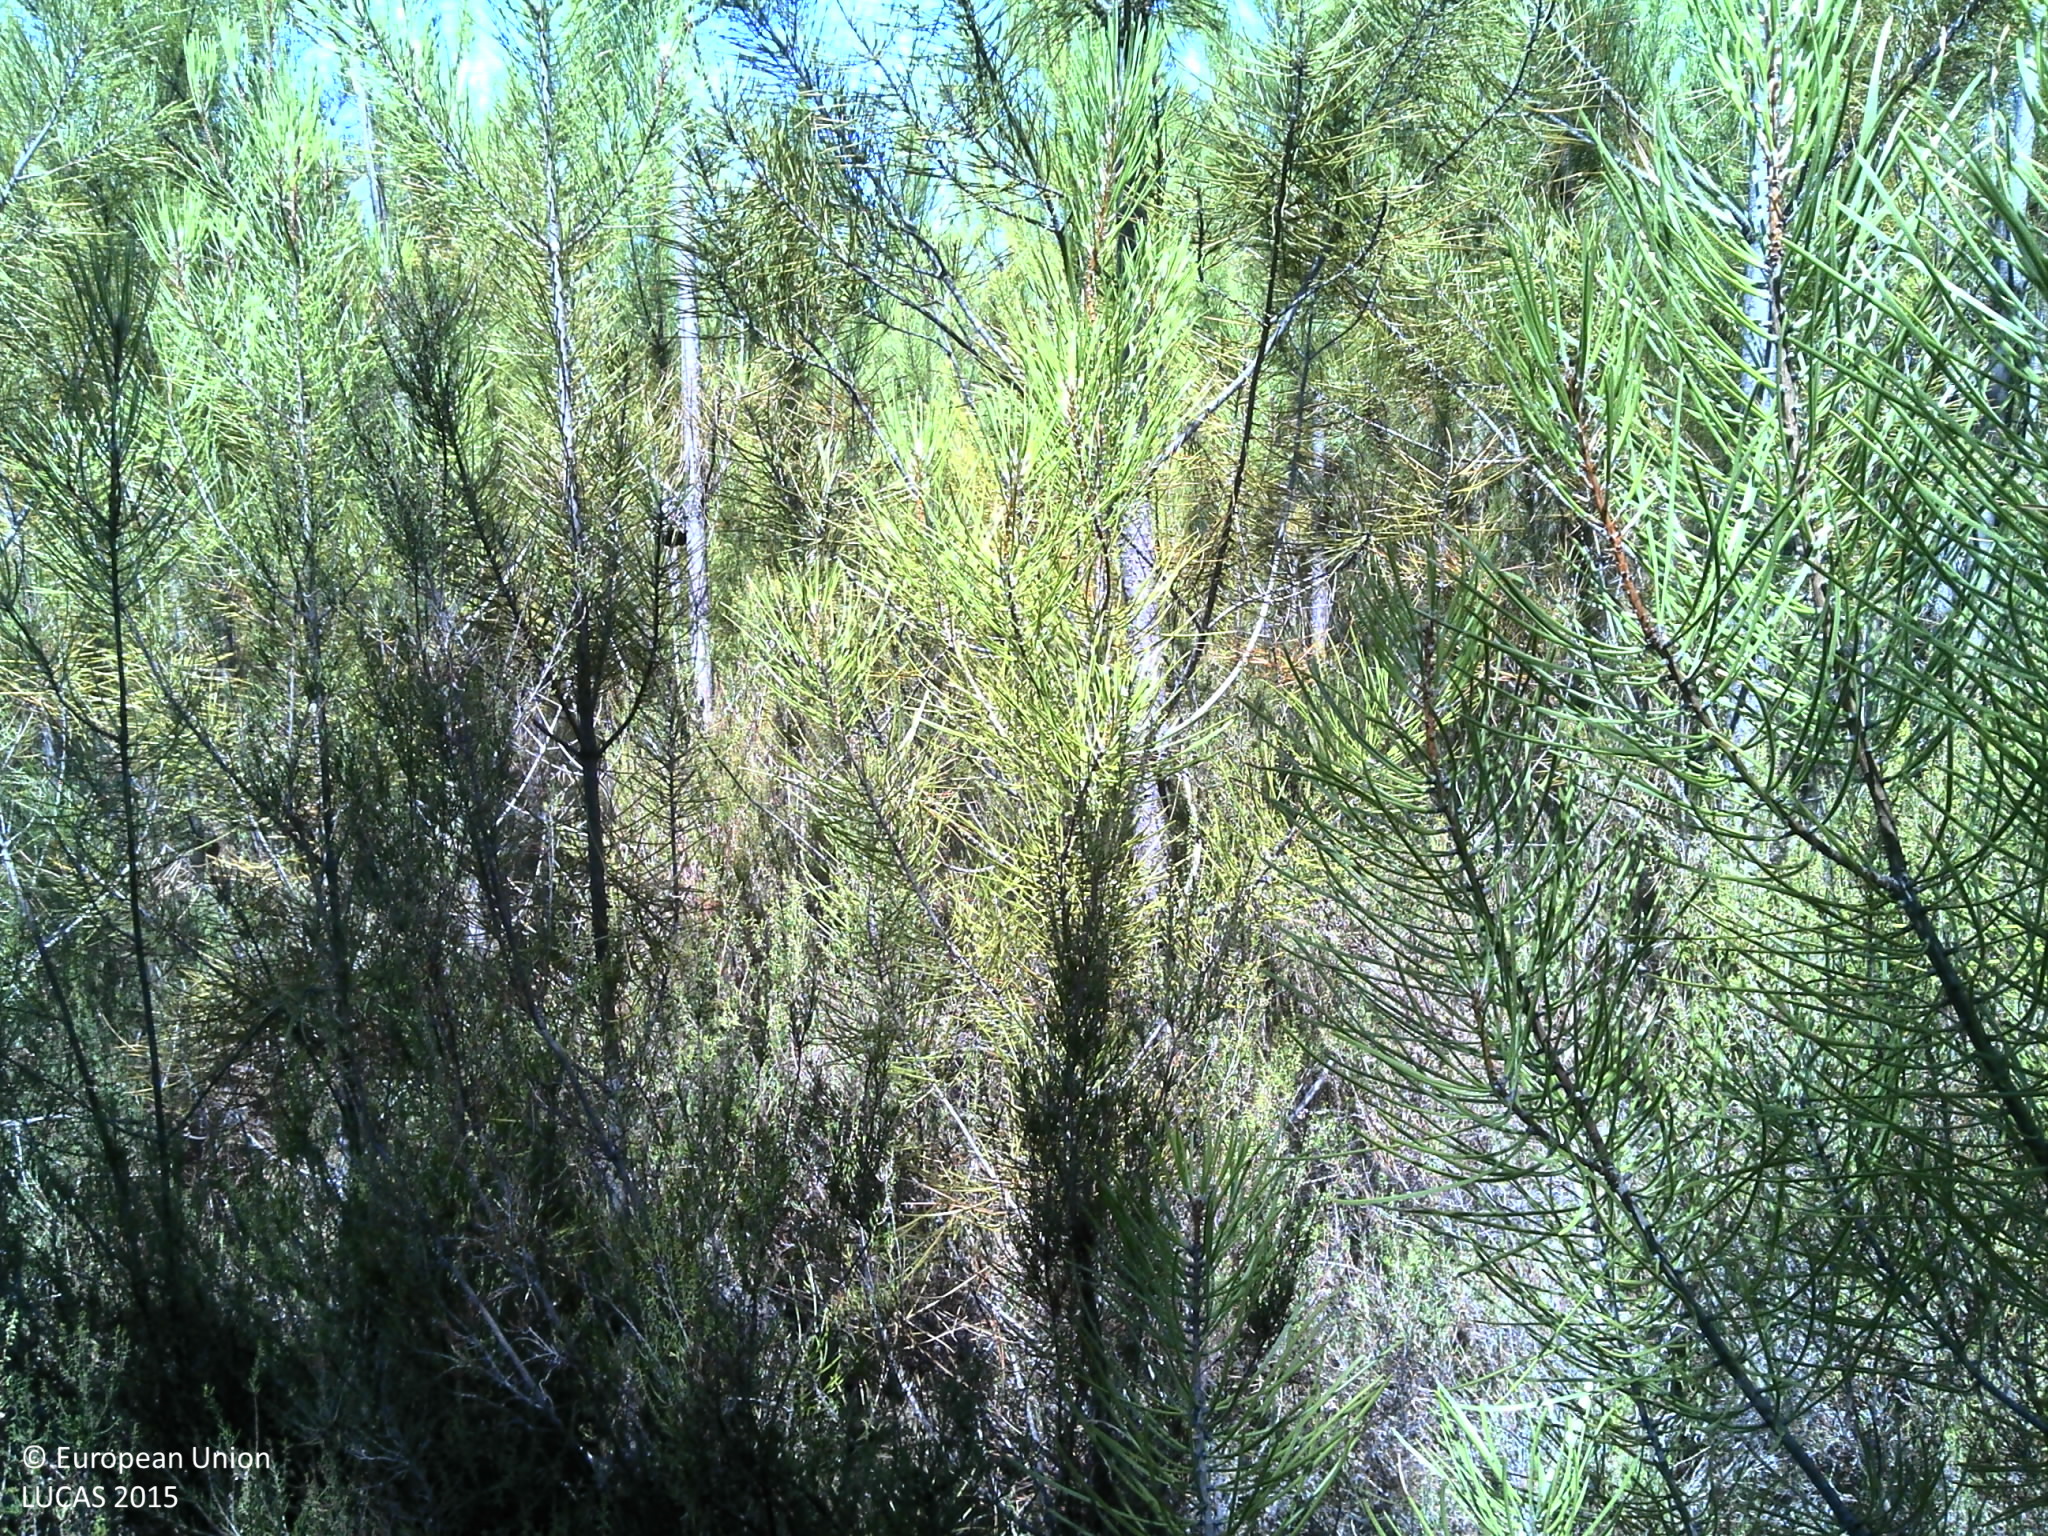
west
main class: Woodland
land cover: Pine dominated coniferous woodland
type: coniferous forest of the mediterranean region
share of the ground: 50 - 75 %
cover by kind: coniferous forest trees 50 %, shrubs 40 %, unconsolidated bare surface 10 %
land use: Forestry
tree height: < 5 m
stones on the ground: > 50 %
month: July
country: PT
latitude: 39.7848
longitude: -7.8200
